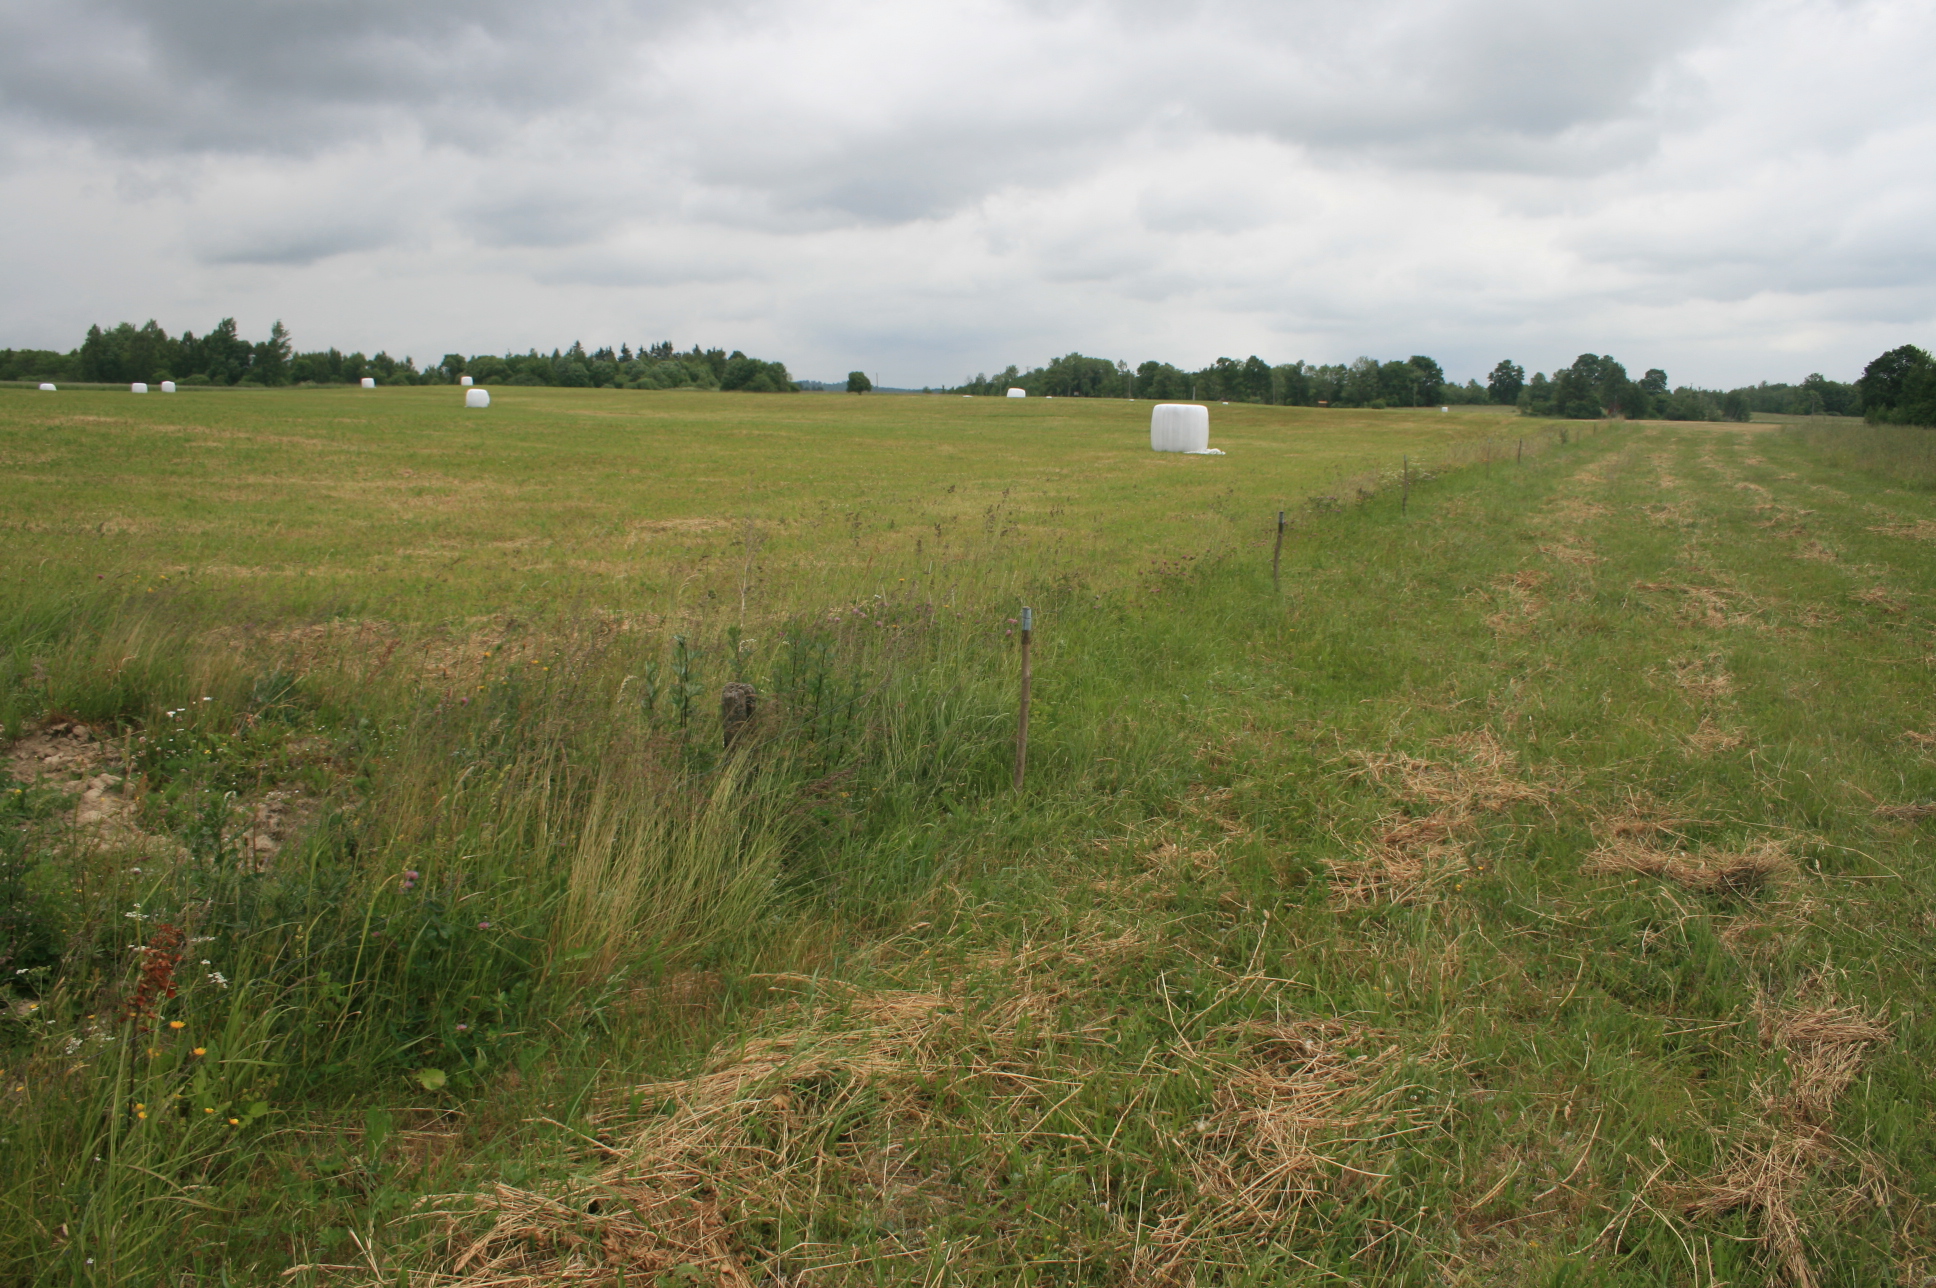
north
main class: Grassland
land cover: Grassland without tree/shrub cover
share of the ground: > 75 %
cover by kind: herbaceous plants 100 %
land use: Agriculture (excluding fallow land and kitchen gardens)
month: June
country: LT
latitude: 55.5848
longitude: 22.3859
